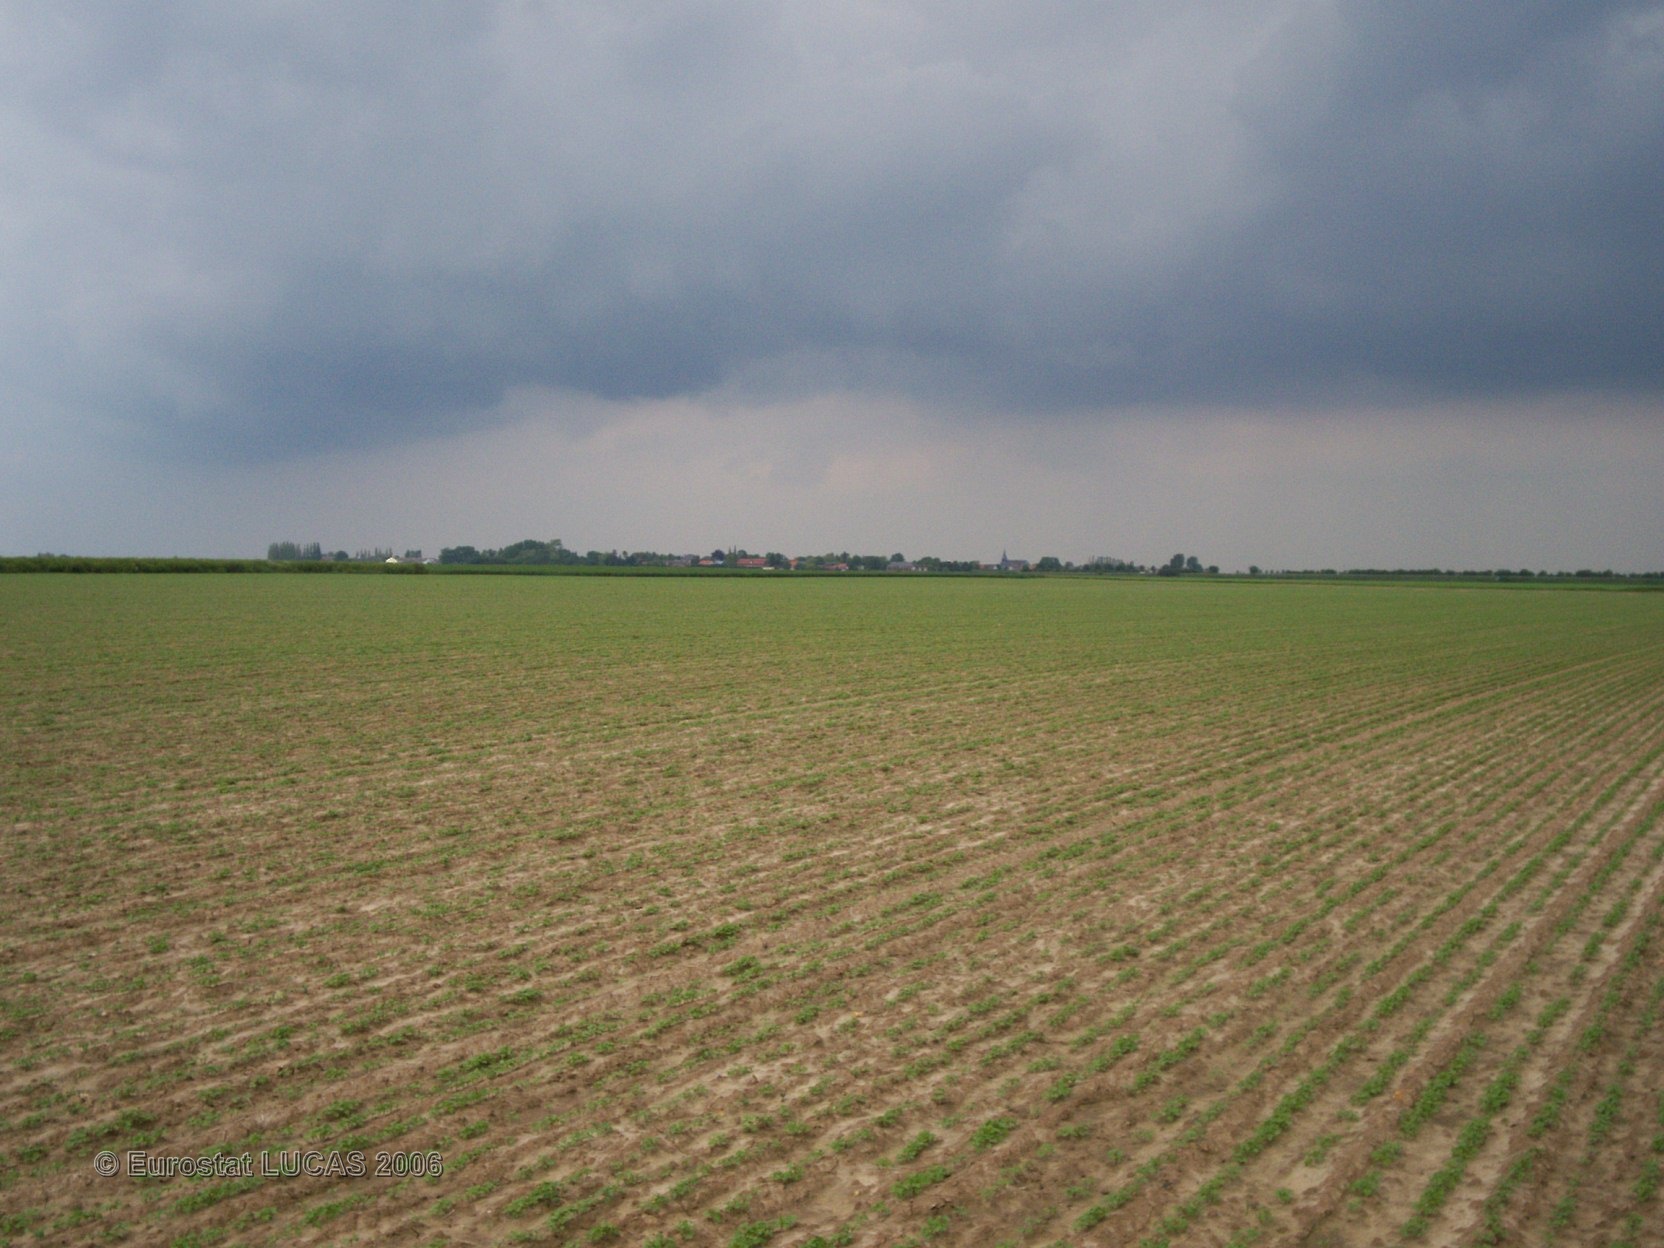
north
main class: Cropland
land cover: Other root crops
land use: Agriculture (excluding fallow land and kitchen gardens)
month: June
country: FR
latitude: 49.7319
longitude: 2.6772
